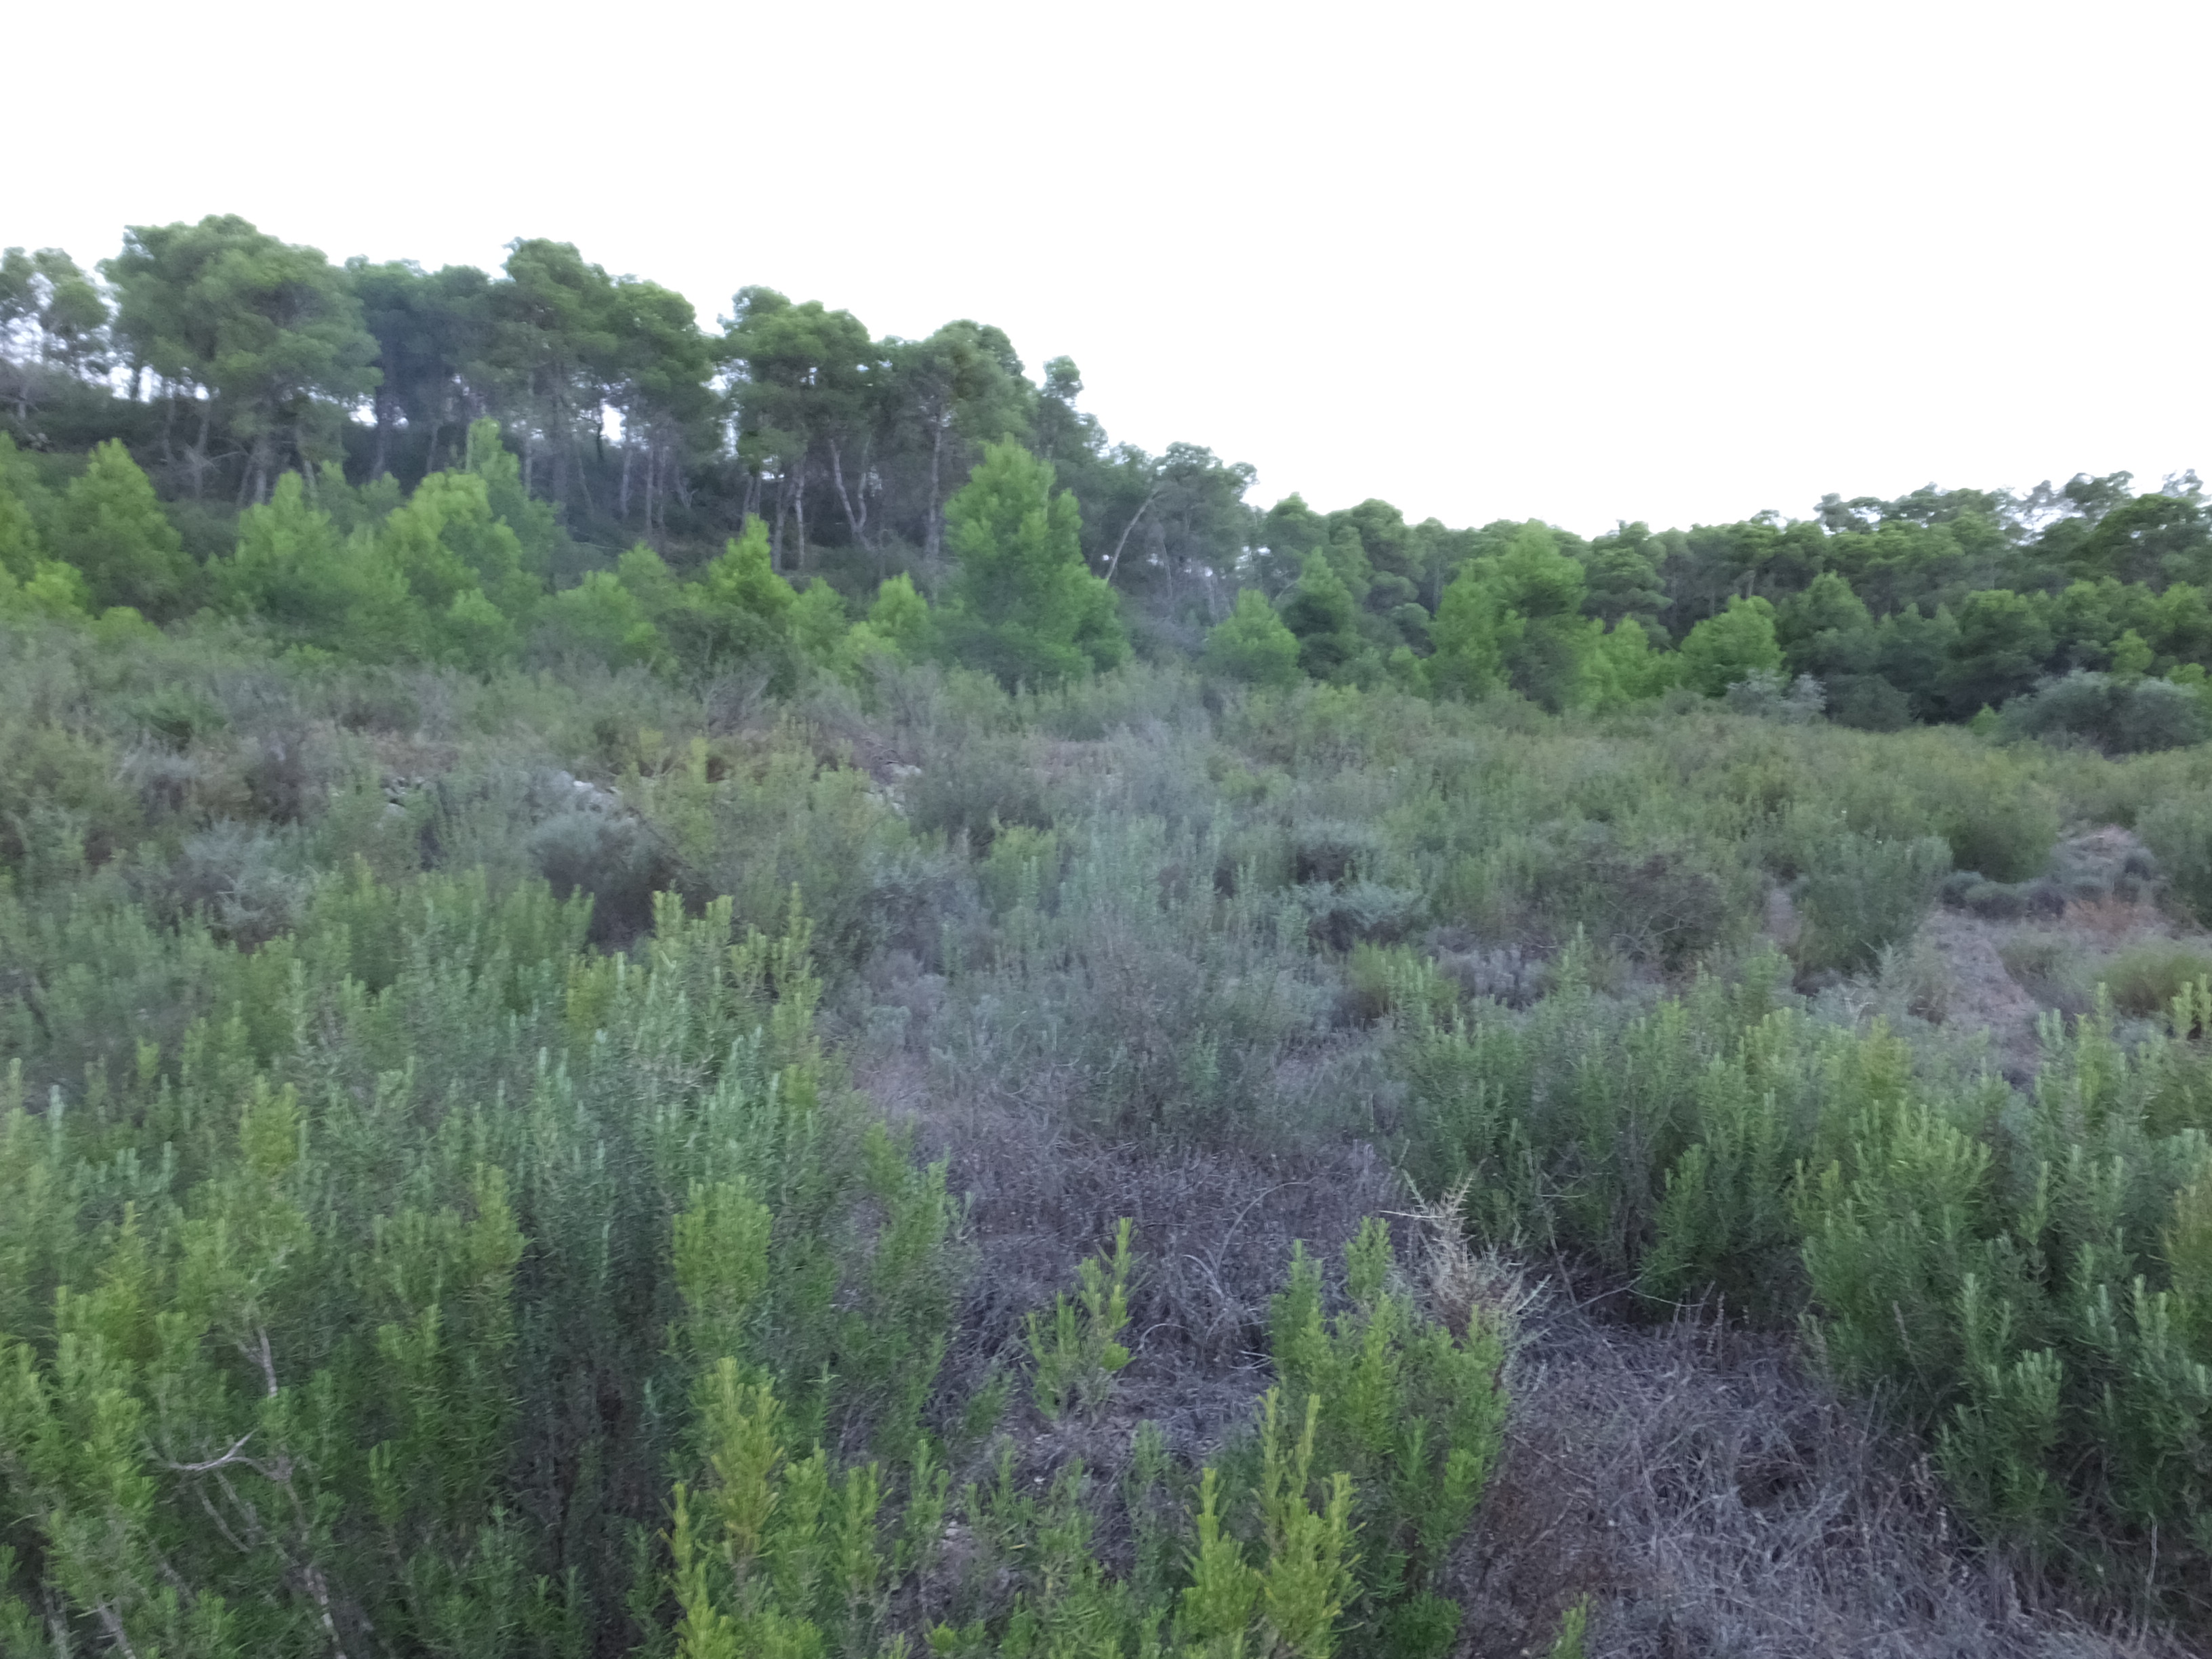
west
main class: Shrubland
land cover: Shrubland with sparse tree cover
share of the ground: > 75 %
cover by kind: shrubs 75 %, herbaceous plants 20 %, coniferous forest trees 5 %
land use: Abandoned areas
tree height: < 5 m
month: August
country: ES
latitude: 41.3568
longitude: 0.1740
